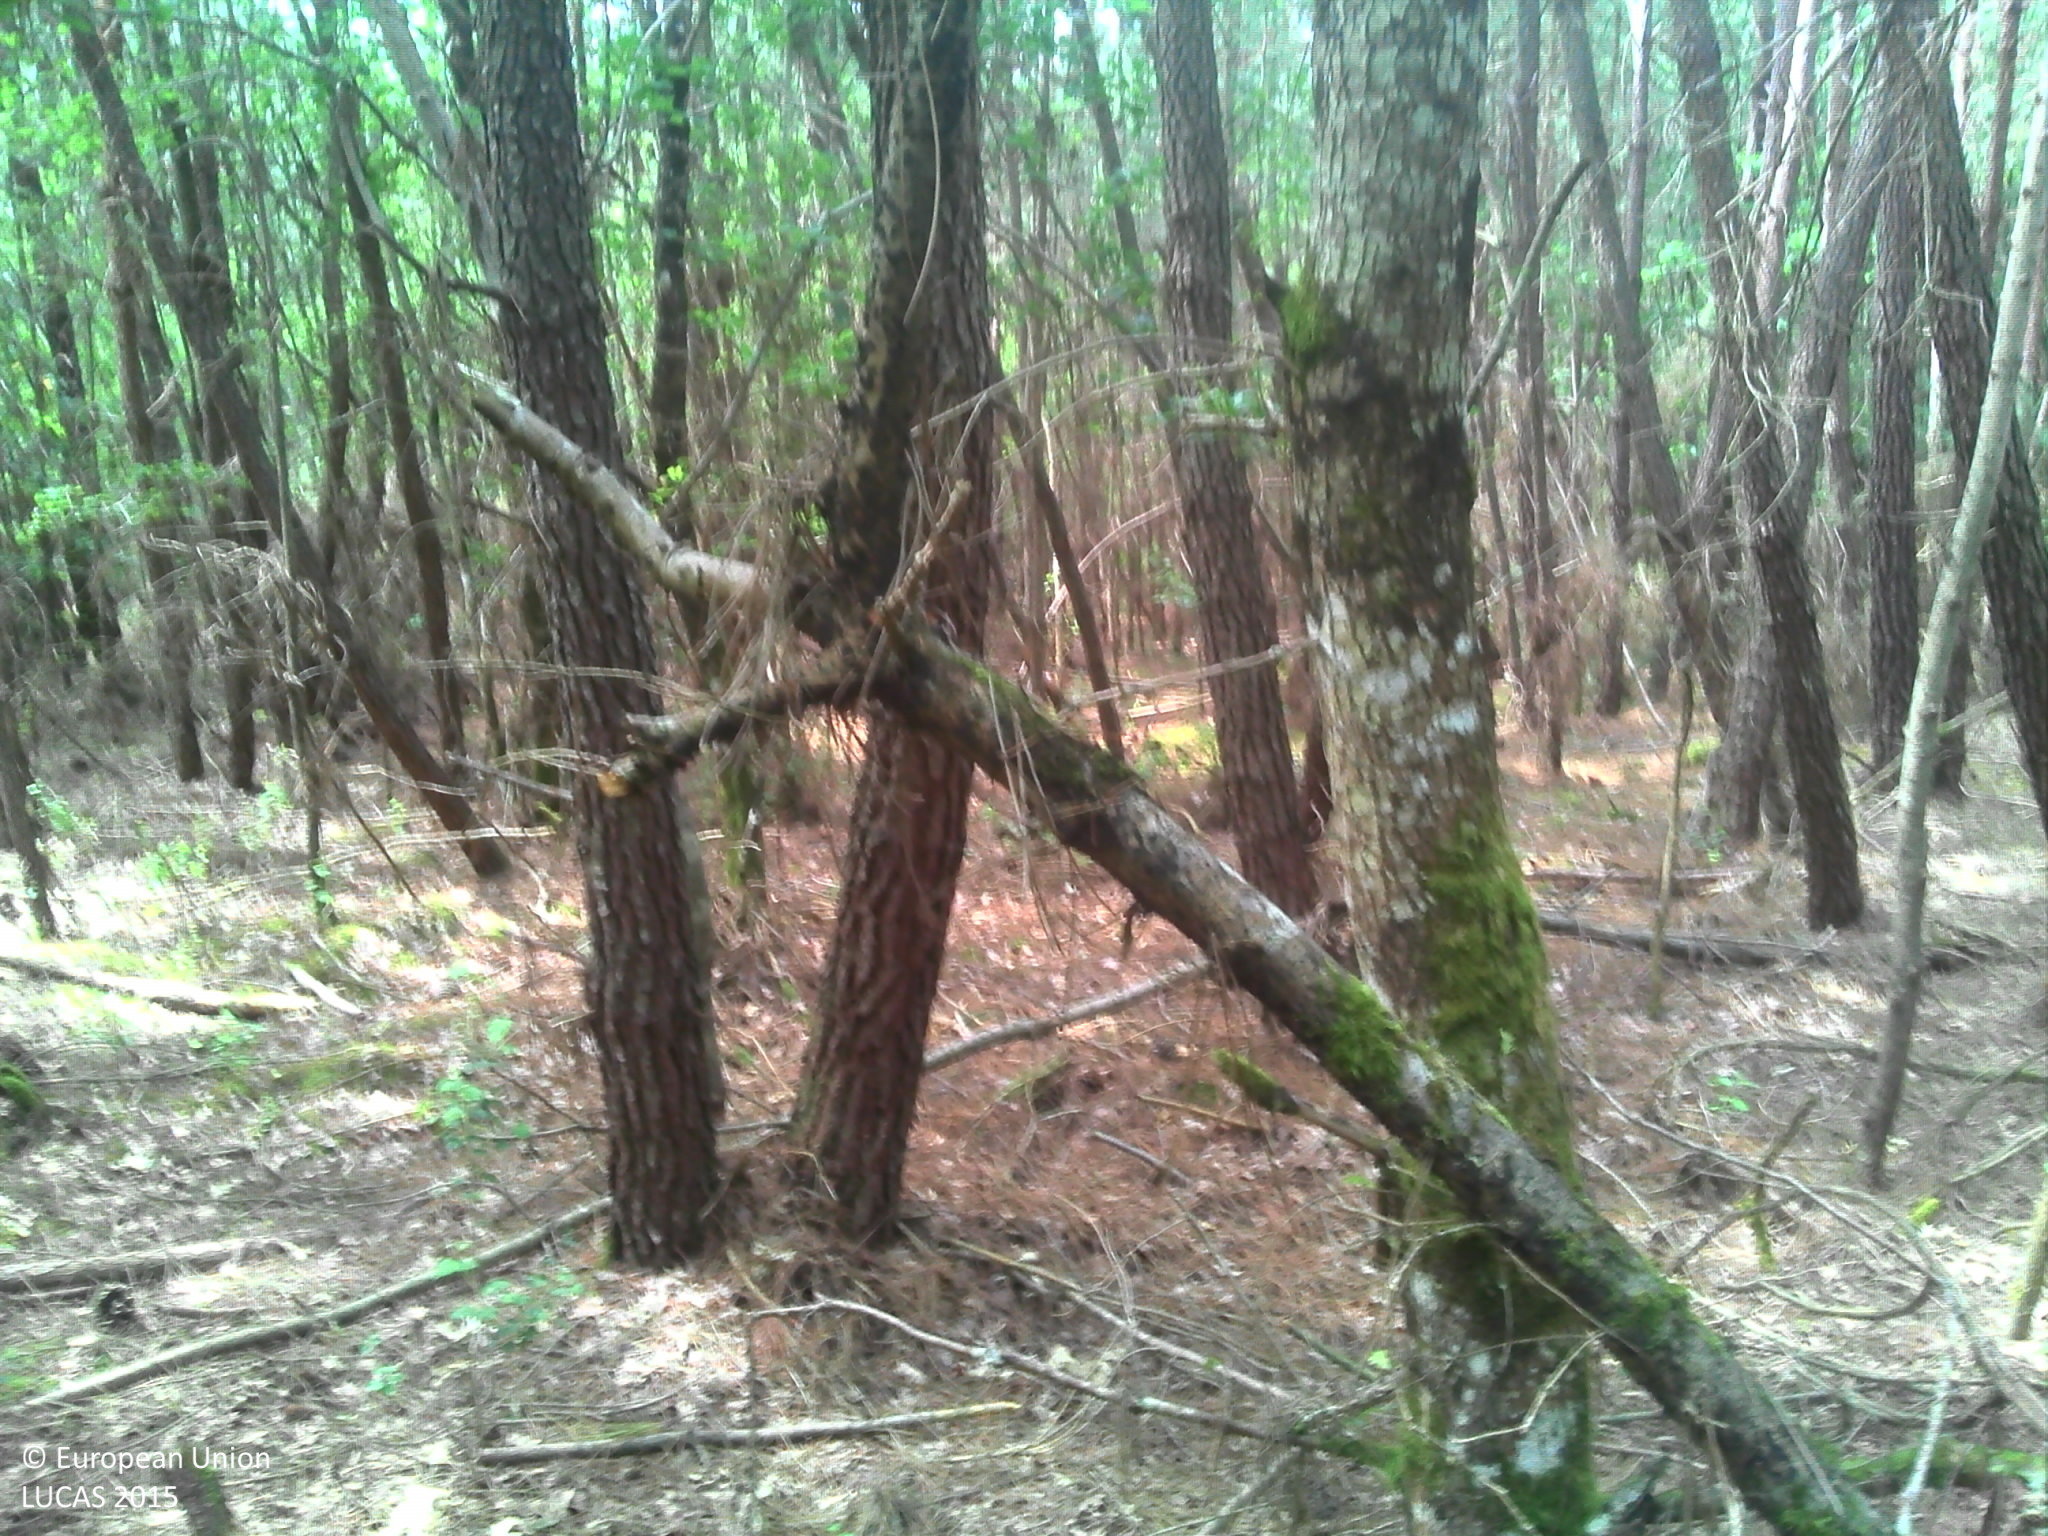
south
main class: Woodland
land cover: Pine dominated mixed woodland
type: thermophilous deciduous forest
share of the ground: > 75 %
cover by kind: unconsolidated bare surface 30 %, herbaceous plants 20 %, lichens and mosses 20 %, coniferous forest trees 15 %, broadleaved forest trees 15 %
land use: Forestry
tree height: > 5 m
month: June
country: FR
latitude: 47.3417
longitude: 1.3694
